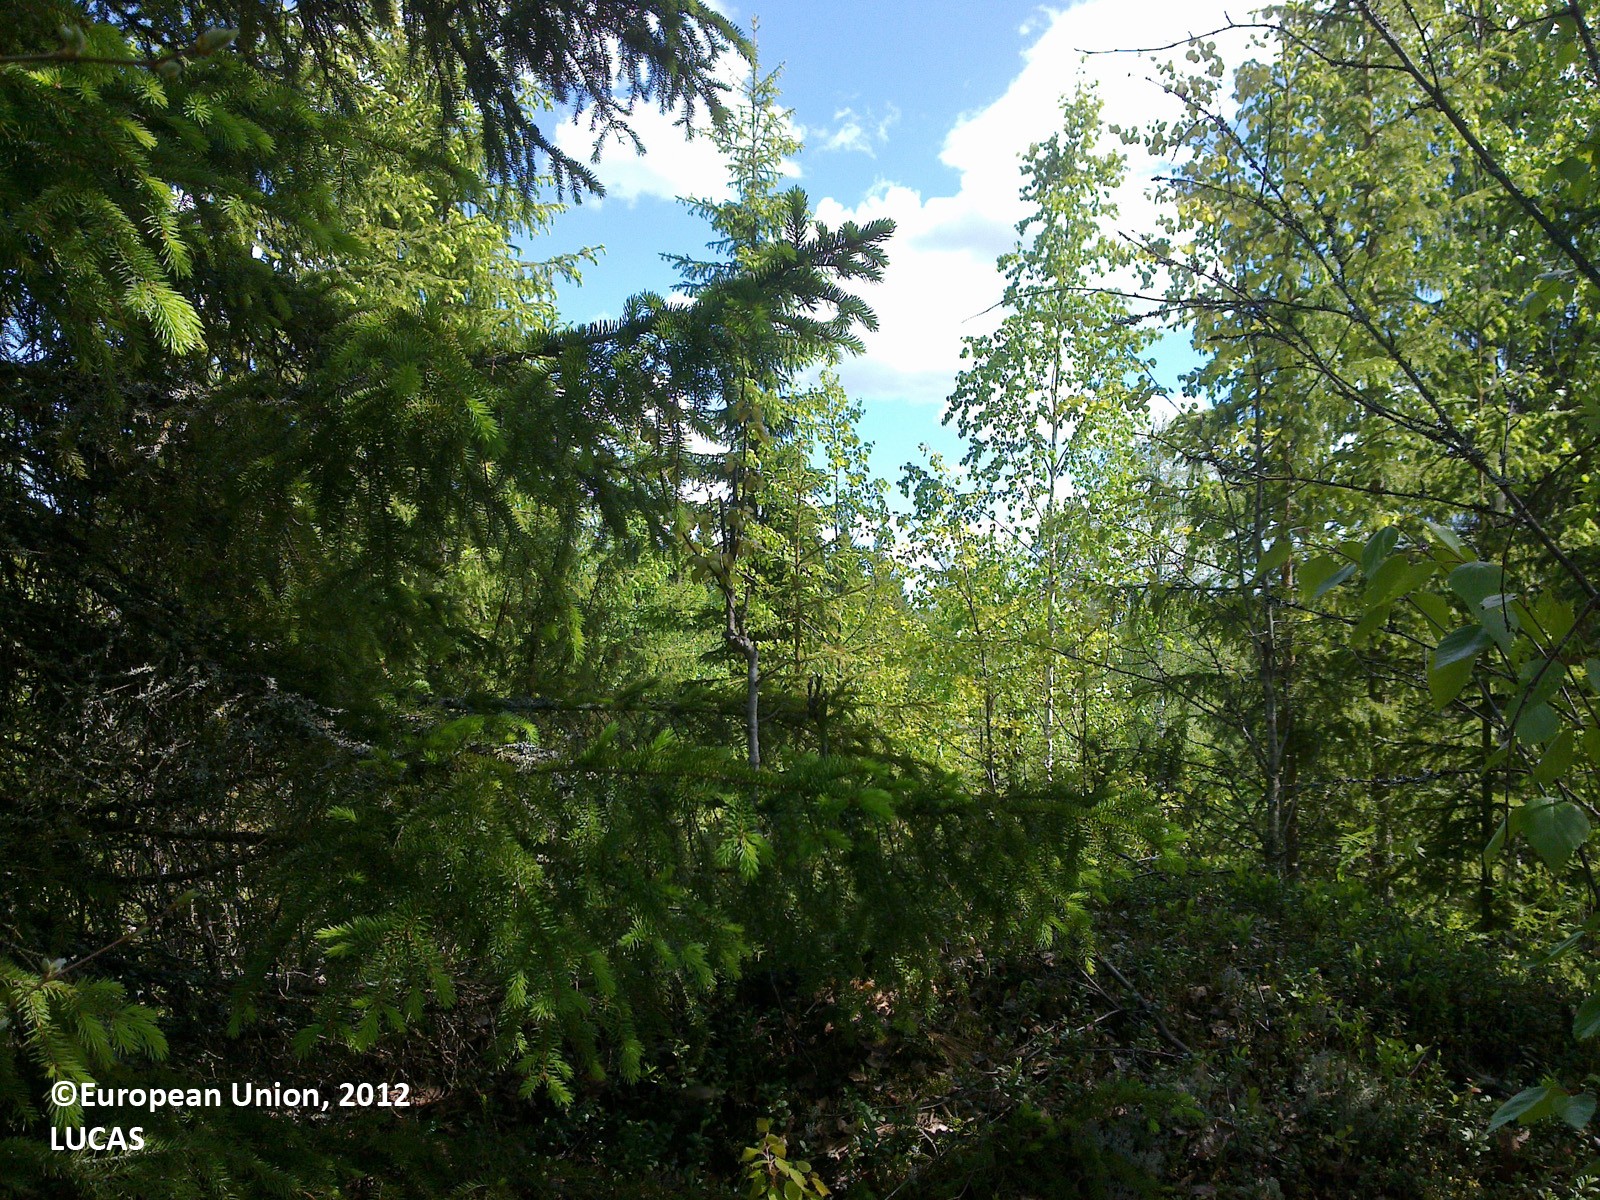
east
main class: Woodland
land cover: Other mixed woodland
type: boreal forest
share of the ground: > 75 %
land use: Forestry
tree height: > 5 m
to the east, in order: Other mixed woodland; Ditches and canals; Spruce dominated coniferous woodland; Ditches and canals; Grassland without tree/shrub cover; Broadleaved woodland; Ditches and canals; Broadleaved woodland; Grassland without tree/shrub cover; Ditches and canals; Shrubland without tree cover; Grassland without tree/shrub cover; Broadleaved woodland; Ditches and canals; Grassland without tree/shrub cover; Other mixed woodland
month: June
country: FI
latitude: 62.5762
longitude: 30.5437
